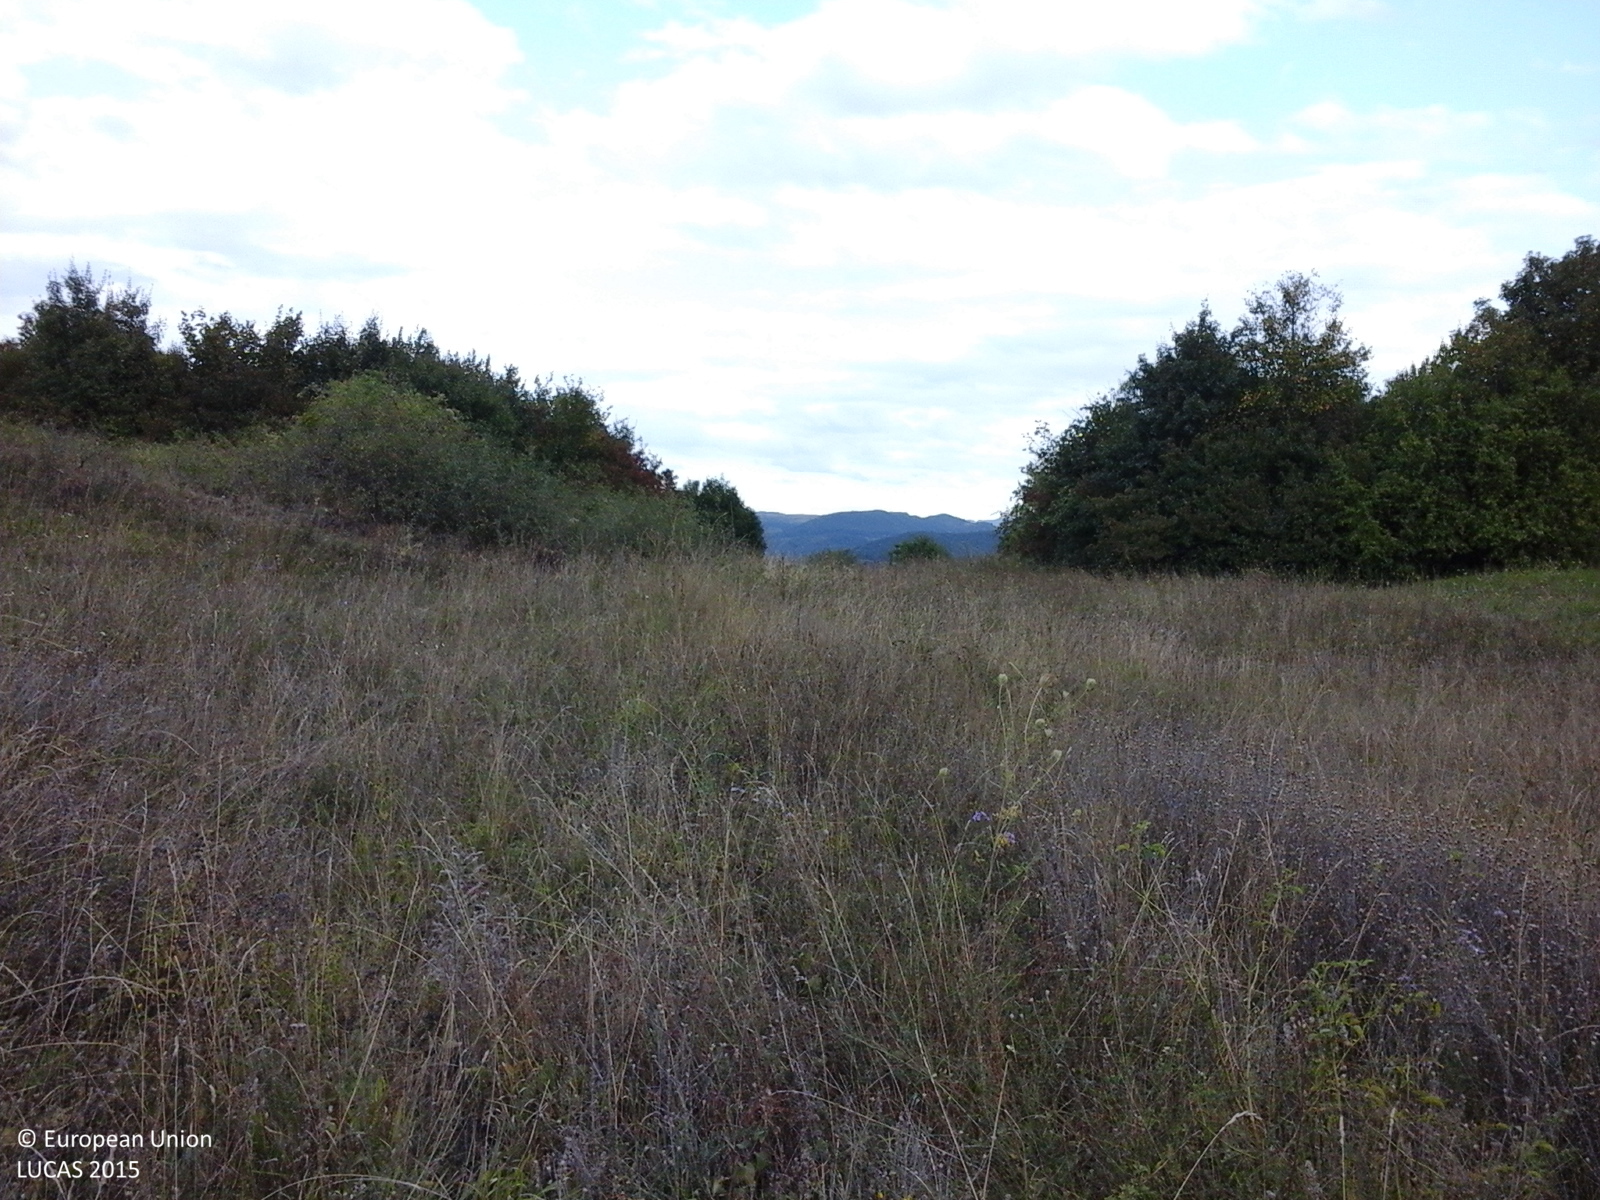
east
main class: Grassland
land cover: Spontaneously vegetated surfaces
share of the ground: > 75 %
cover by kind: herbaceous plants 100 %
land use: Agriculture (excluding fallow land and kitchen gardens)
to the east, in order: Spontaneously vegetated surfaces; Tracks; Grassland without tree/shrub cover; Shrubland without tree cover; Grassland without tree/shrub cover; Shrubland with sparse tree cover; Grassland without tree/shrub cover; Broadleaved woodland; Grassland without tree/shrub cover; Single bushes/trees; Grassland with sparse tree/shrub cover; Tracks; Grassland with sparse tree/shrub cover; Other fruit trees and berries; Grassland without tree/shrub cover
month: September
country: RO
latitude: 47.2498
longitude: 23.2946
